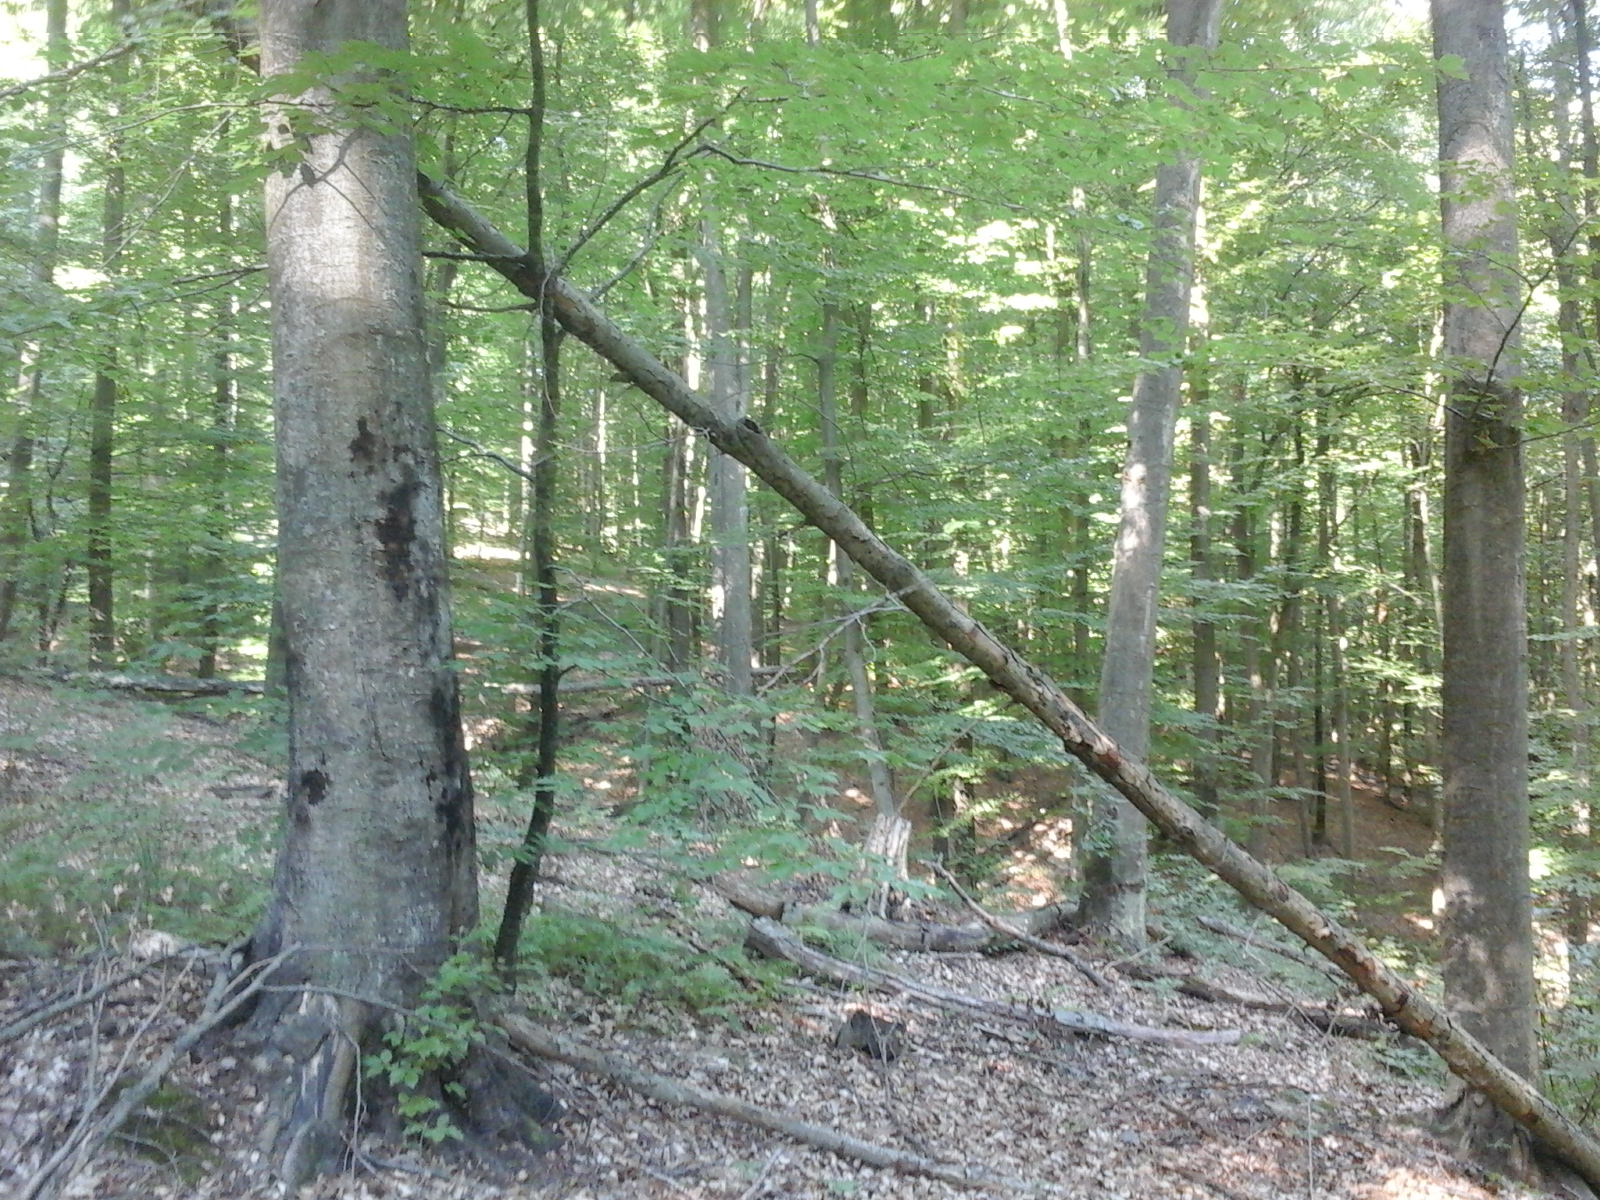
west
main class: Woodland
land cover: Broadleaved woodland
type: beech forest
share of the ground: > 75 %
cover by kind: broadleaved forest trees 100 %
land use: Forestry
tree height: > 5 m
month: August
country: RO
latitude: 46.0143
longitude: 22.1980
